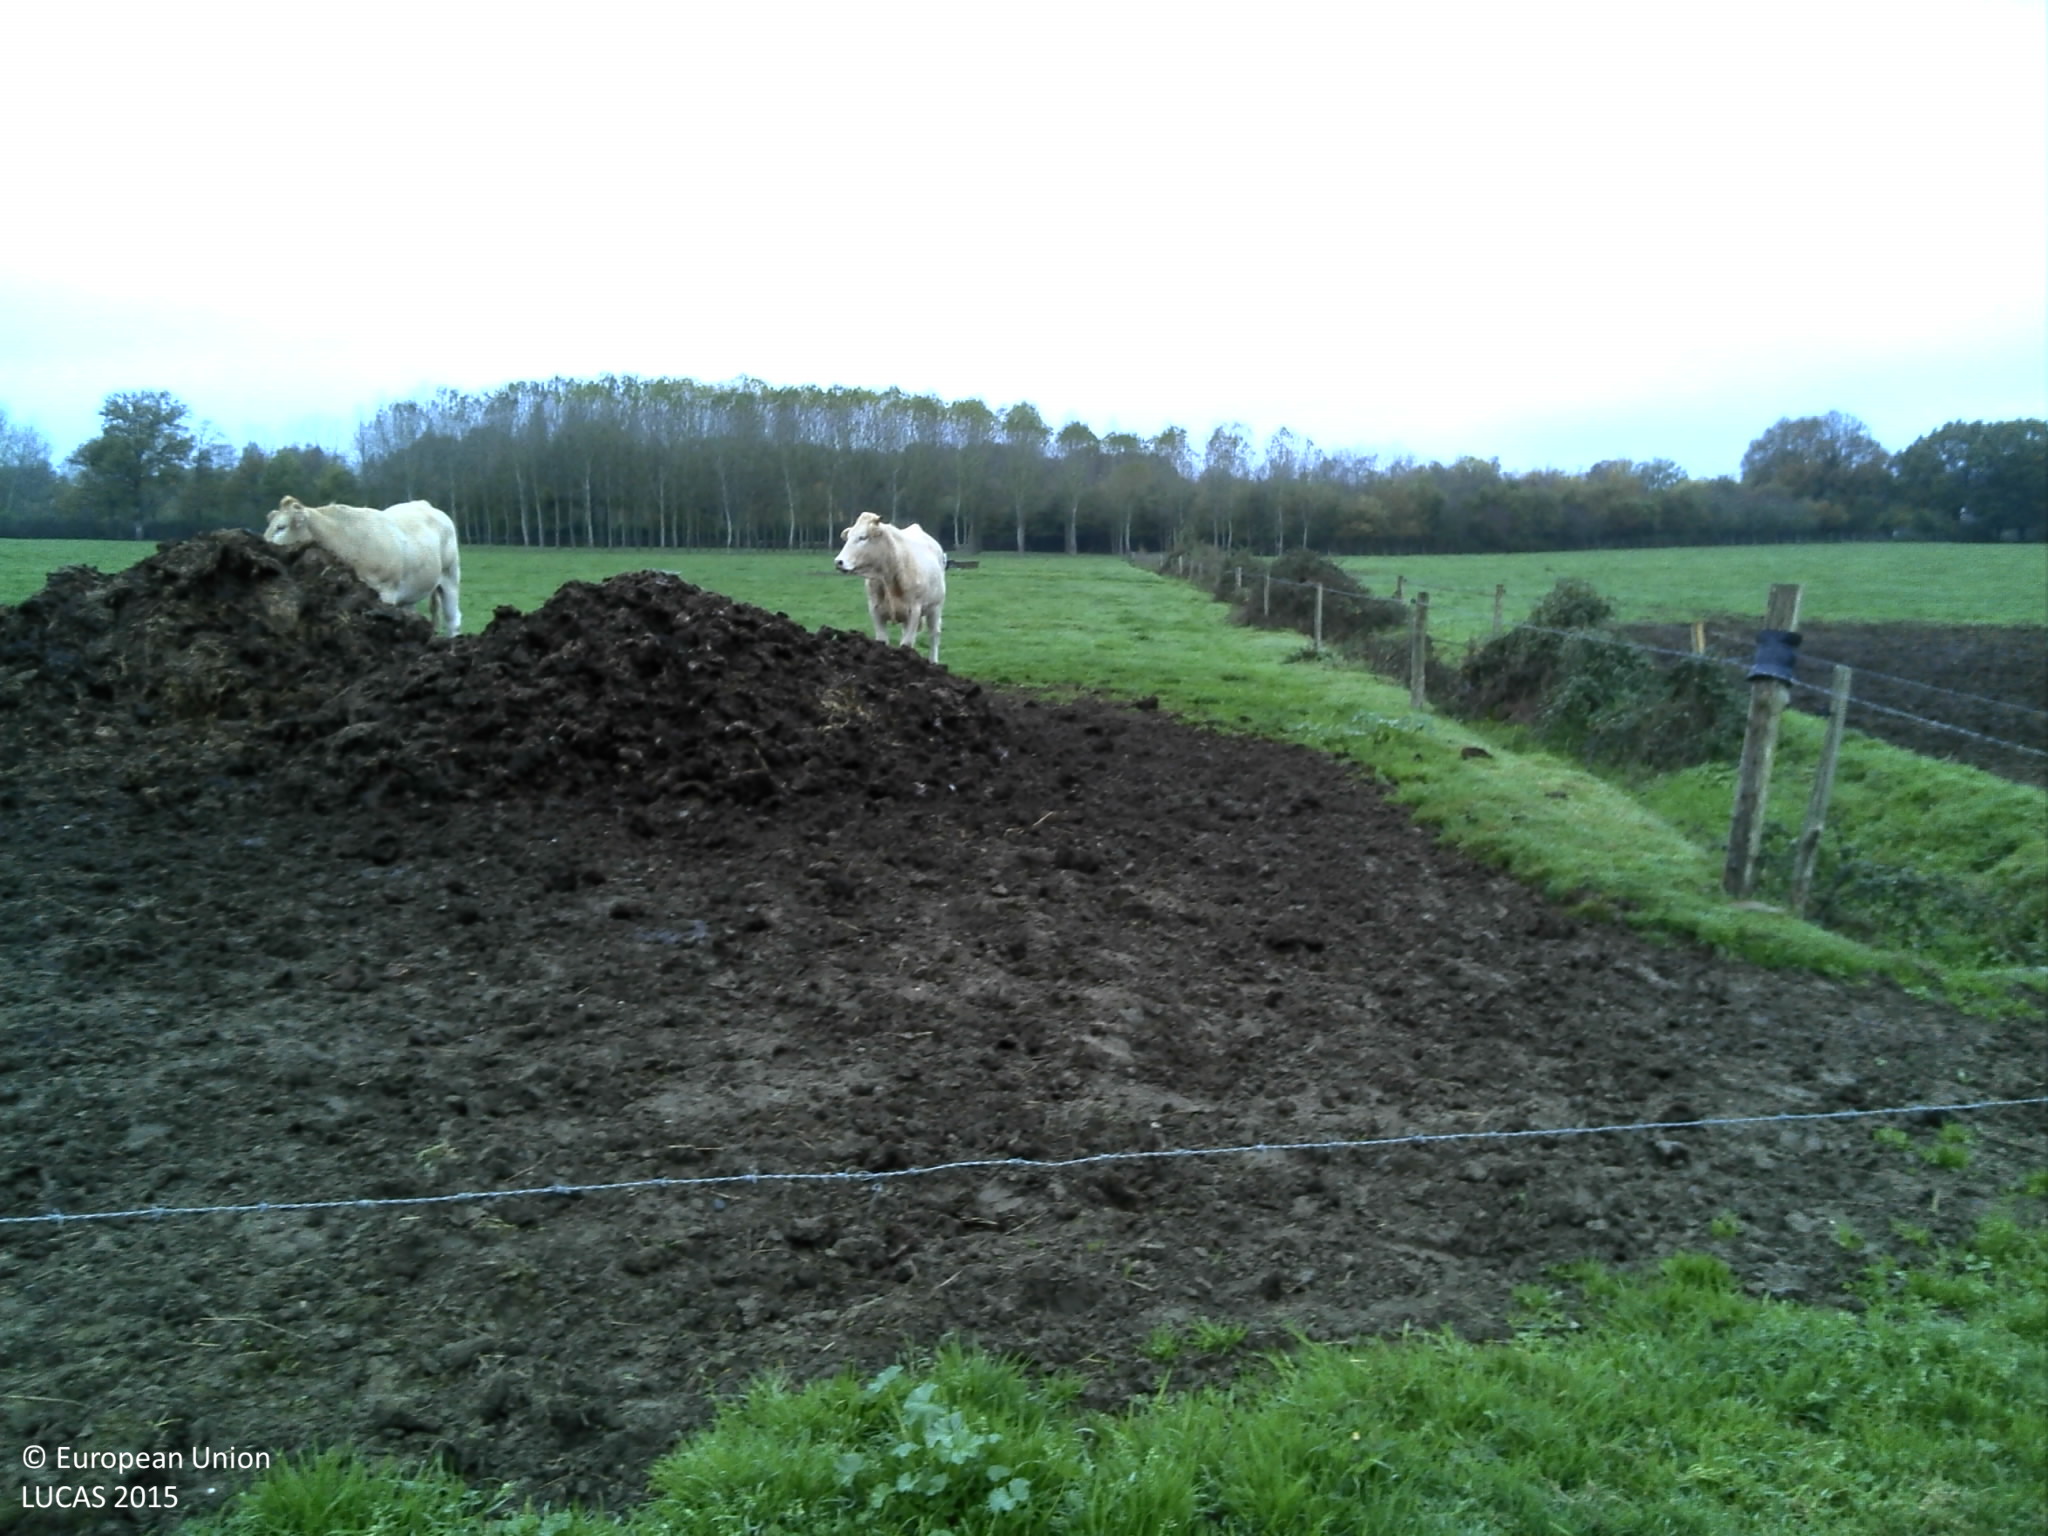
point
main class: Grassland
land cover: Grassland without tree/shrub cover
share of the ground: > 75 %
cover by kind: herbaceous plants 100 %
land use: Agriculture (excluding fallow land and kitchen gardens)
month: November
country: FR
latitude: 47.6867
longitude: -1.3795
